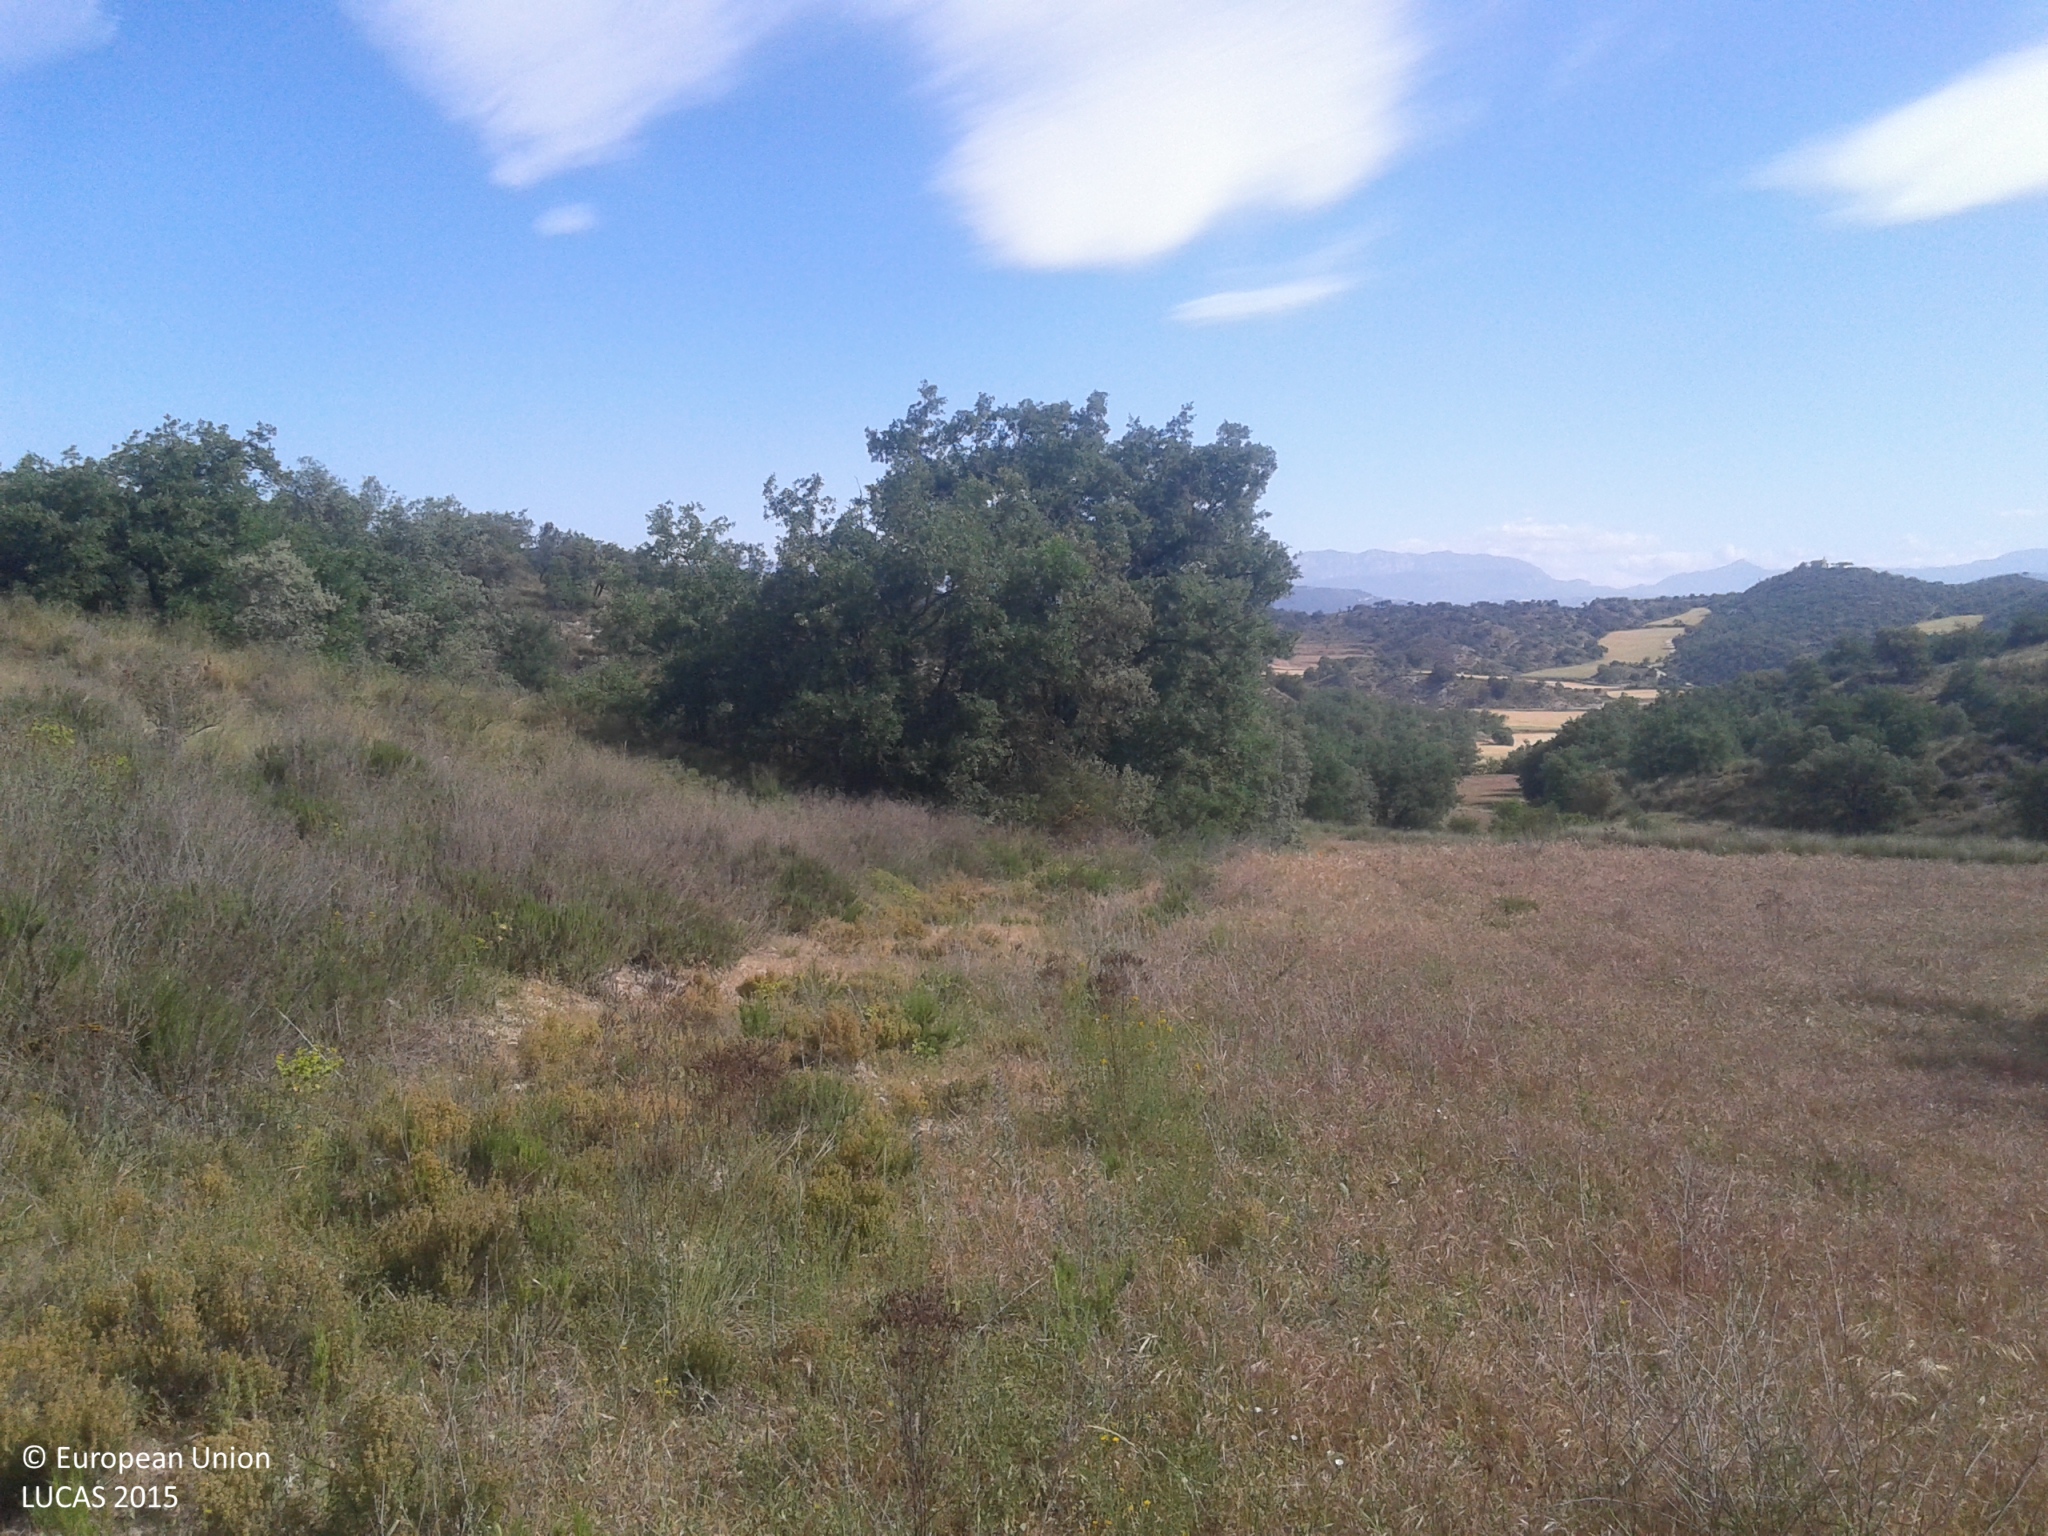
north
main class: Grassland
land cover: Spontaneously vegetated surfaces
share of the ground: > 75 %
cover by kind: herbaceous plants 100 %
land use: Fallow land
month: May
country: ES
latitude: 41.8670
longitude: 1.1570
